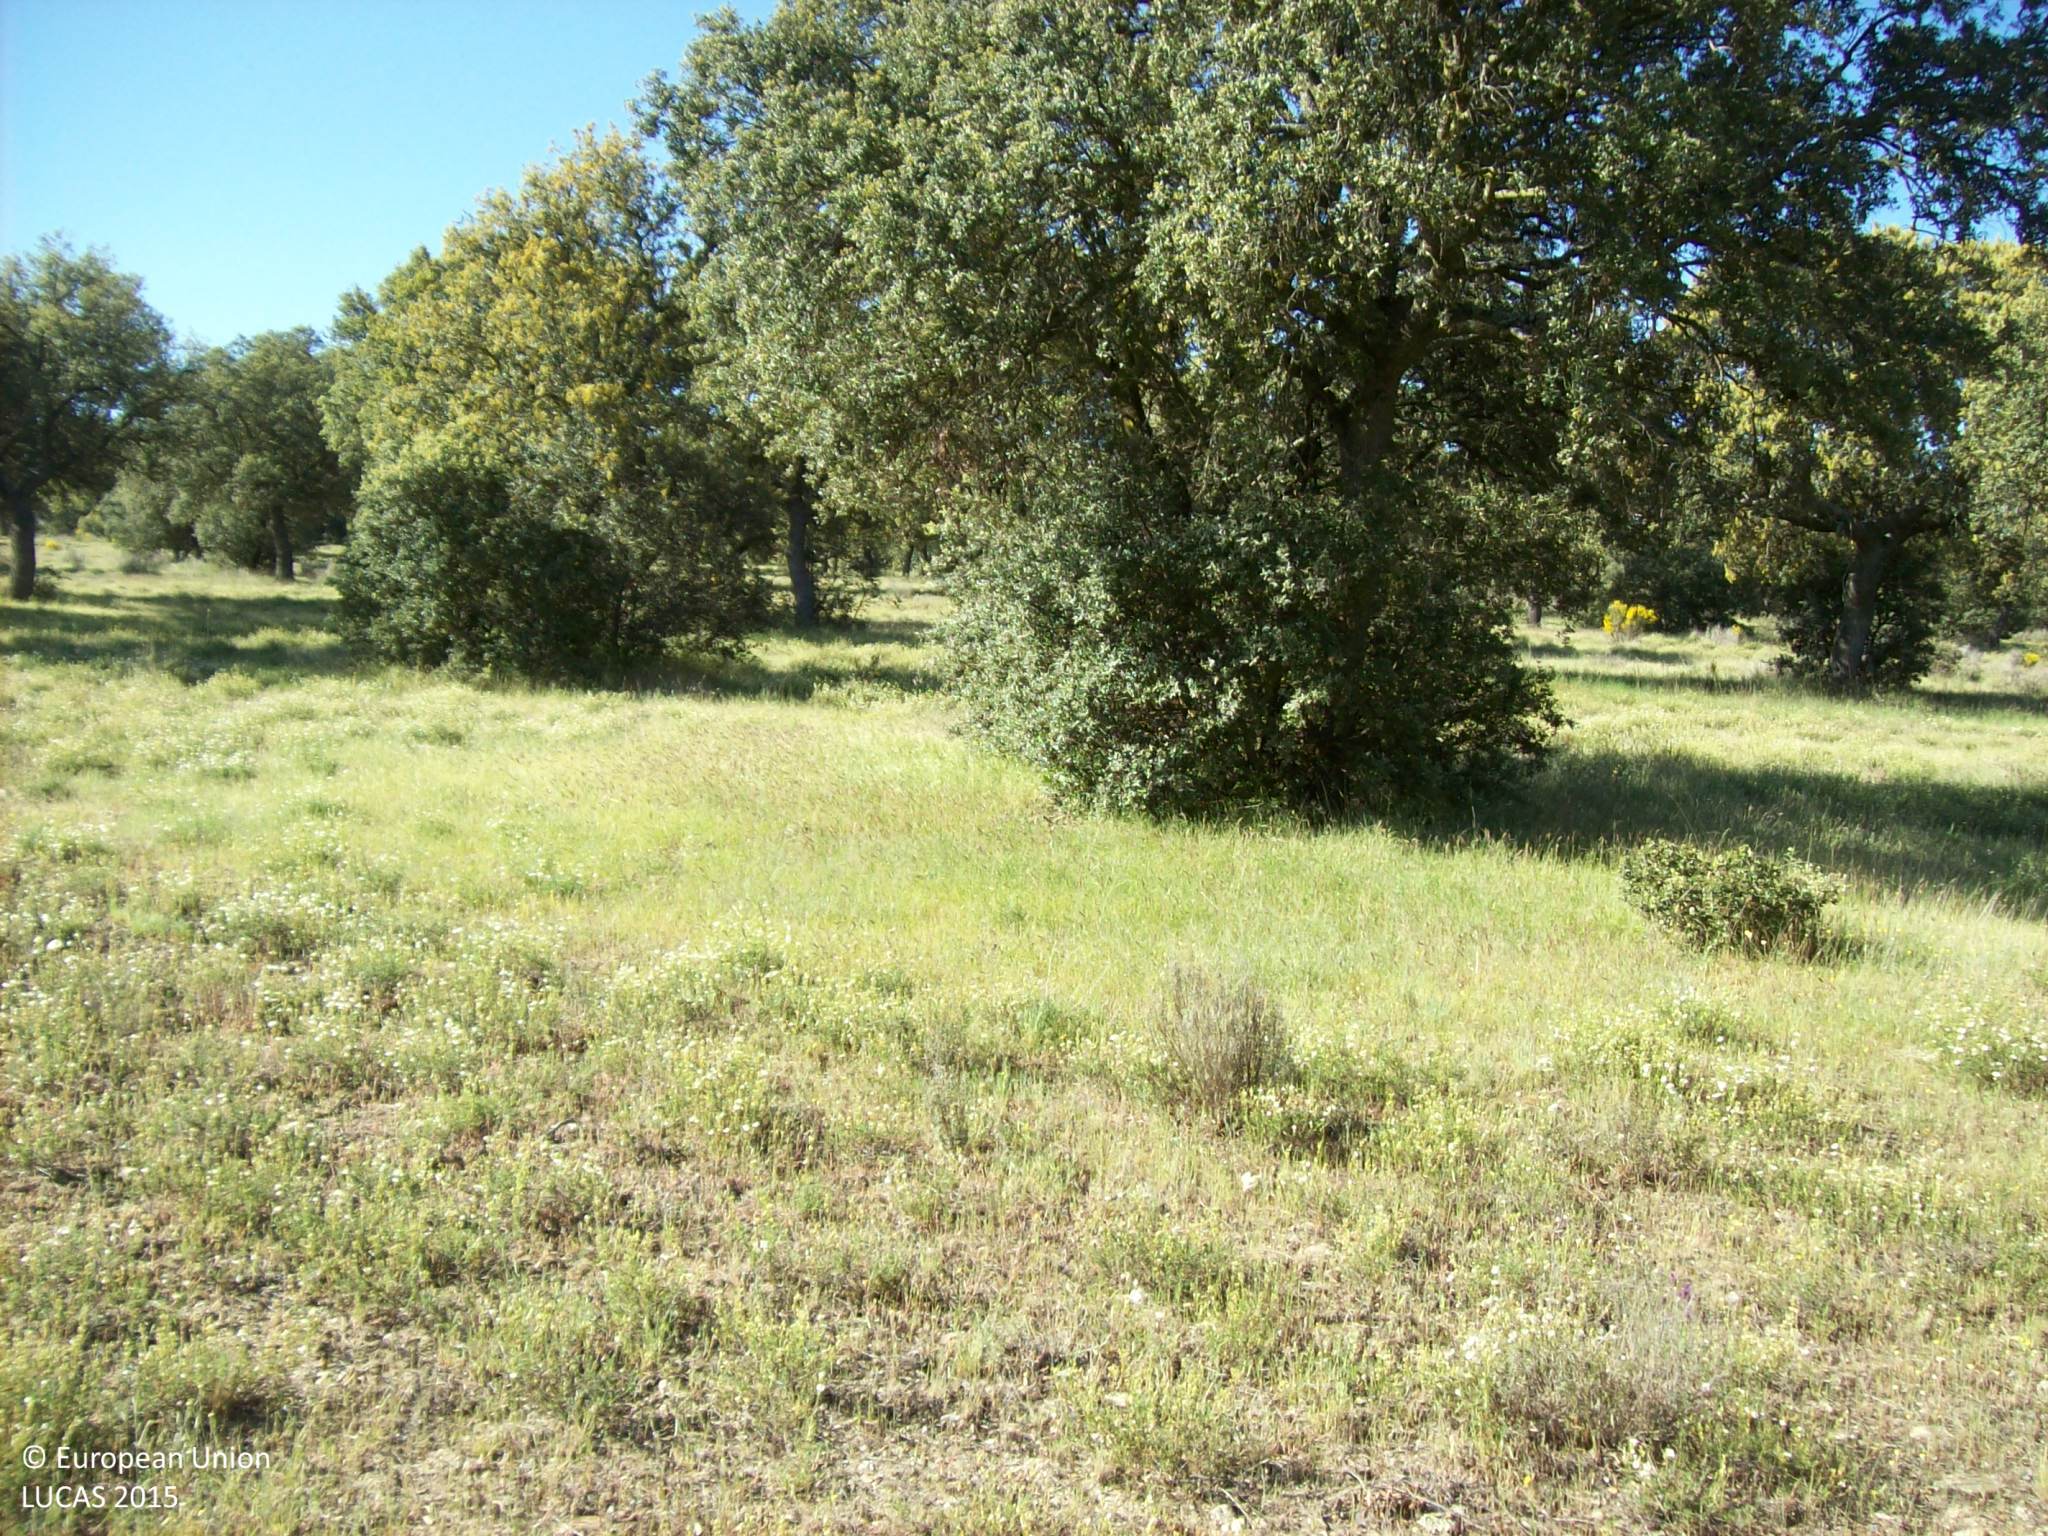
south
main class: Woodland
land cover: Broadleaved woodland
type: broadleaved evergreen forest
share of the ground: 25 - 50 %
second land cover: Grassland without tree/shrub cover
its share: 50 - 75 %
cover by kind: herbaceous plants 65 %, broadleaved forest trees 30 %, shrubs 5 %
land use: Forestry
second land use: Agriculture (excluding fallow land and kitchen gardens)
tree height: > 5 m
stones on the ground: 10 - 25 %
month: May
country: ES
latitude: 40.5682
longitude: -4.9291
